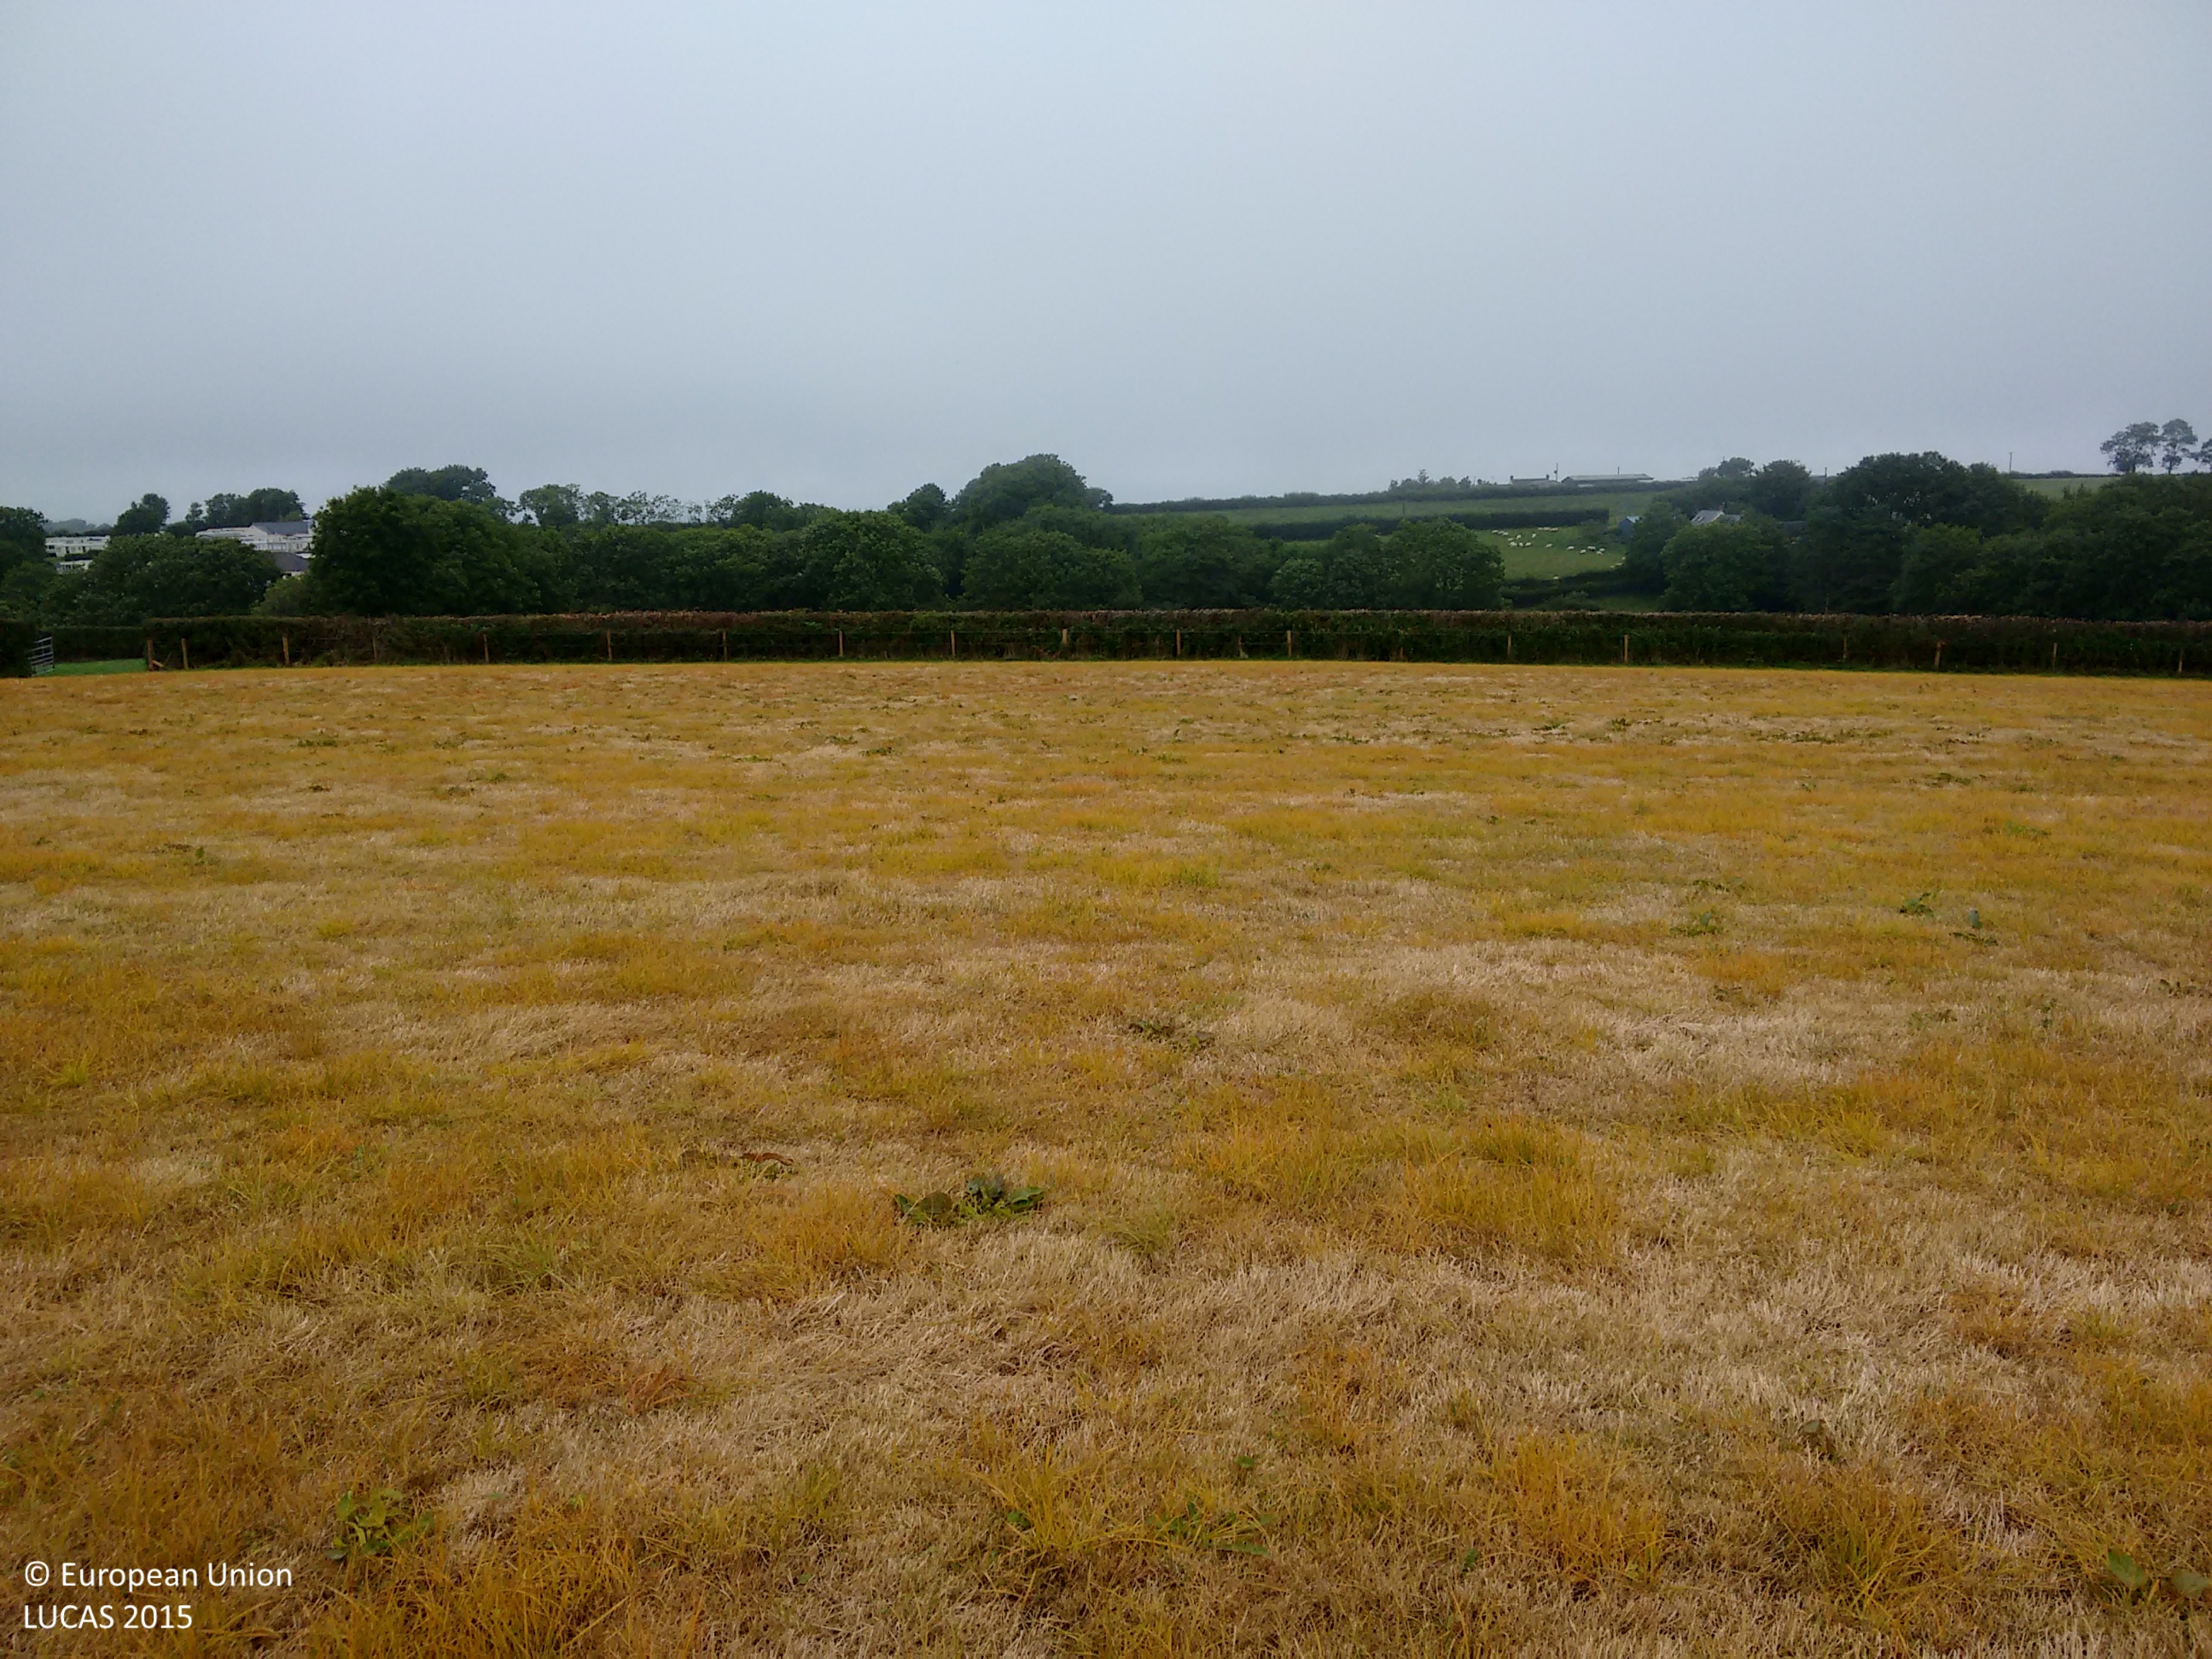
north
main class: Grassland
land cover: Grassland without tree/shrub cover
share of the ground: > 75 %
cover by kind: herbaceous plants 100 %
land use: Agriculture (excluding fallow land and kitchen gardens)
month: August
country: GB
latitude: 51.7836
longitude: -4.7076
